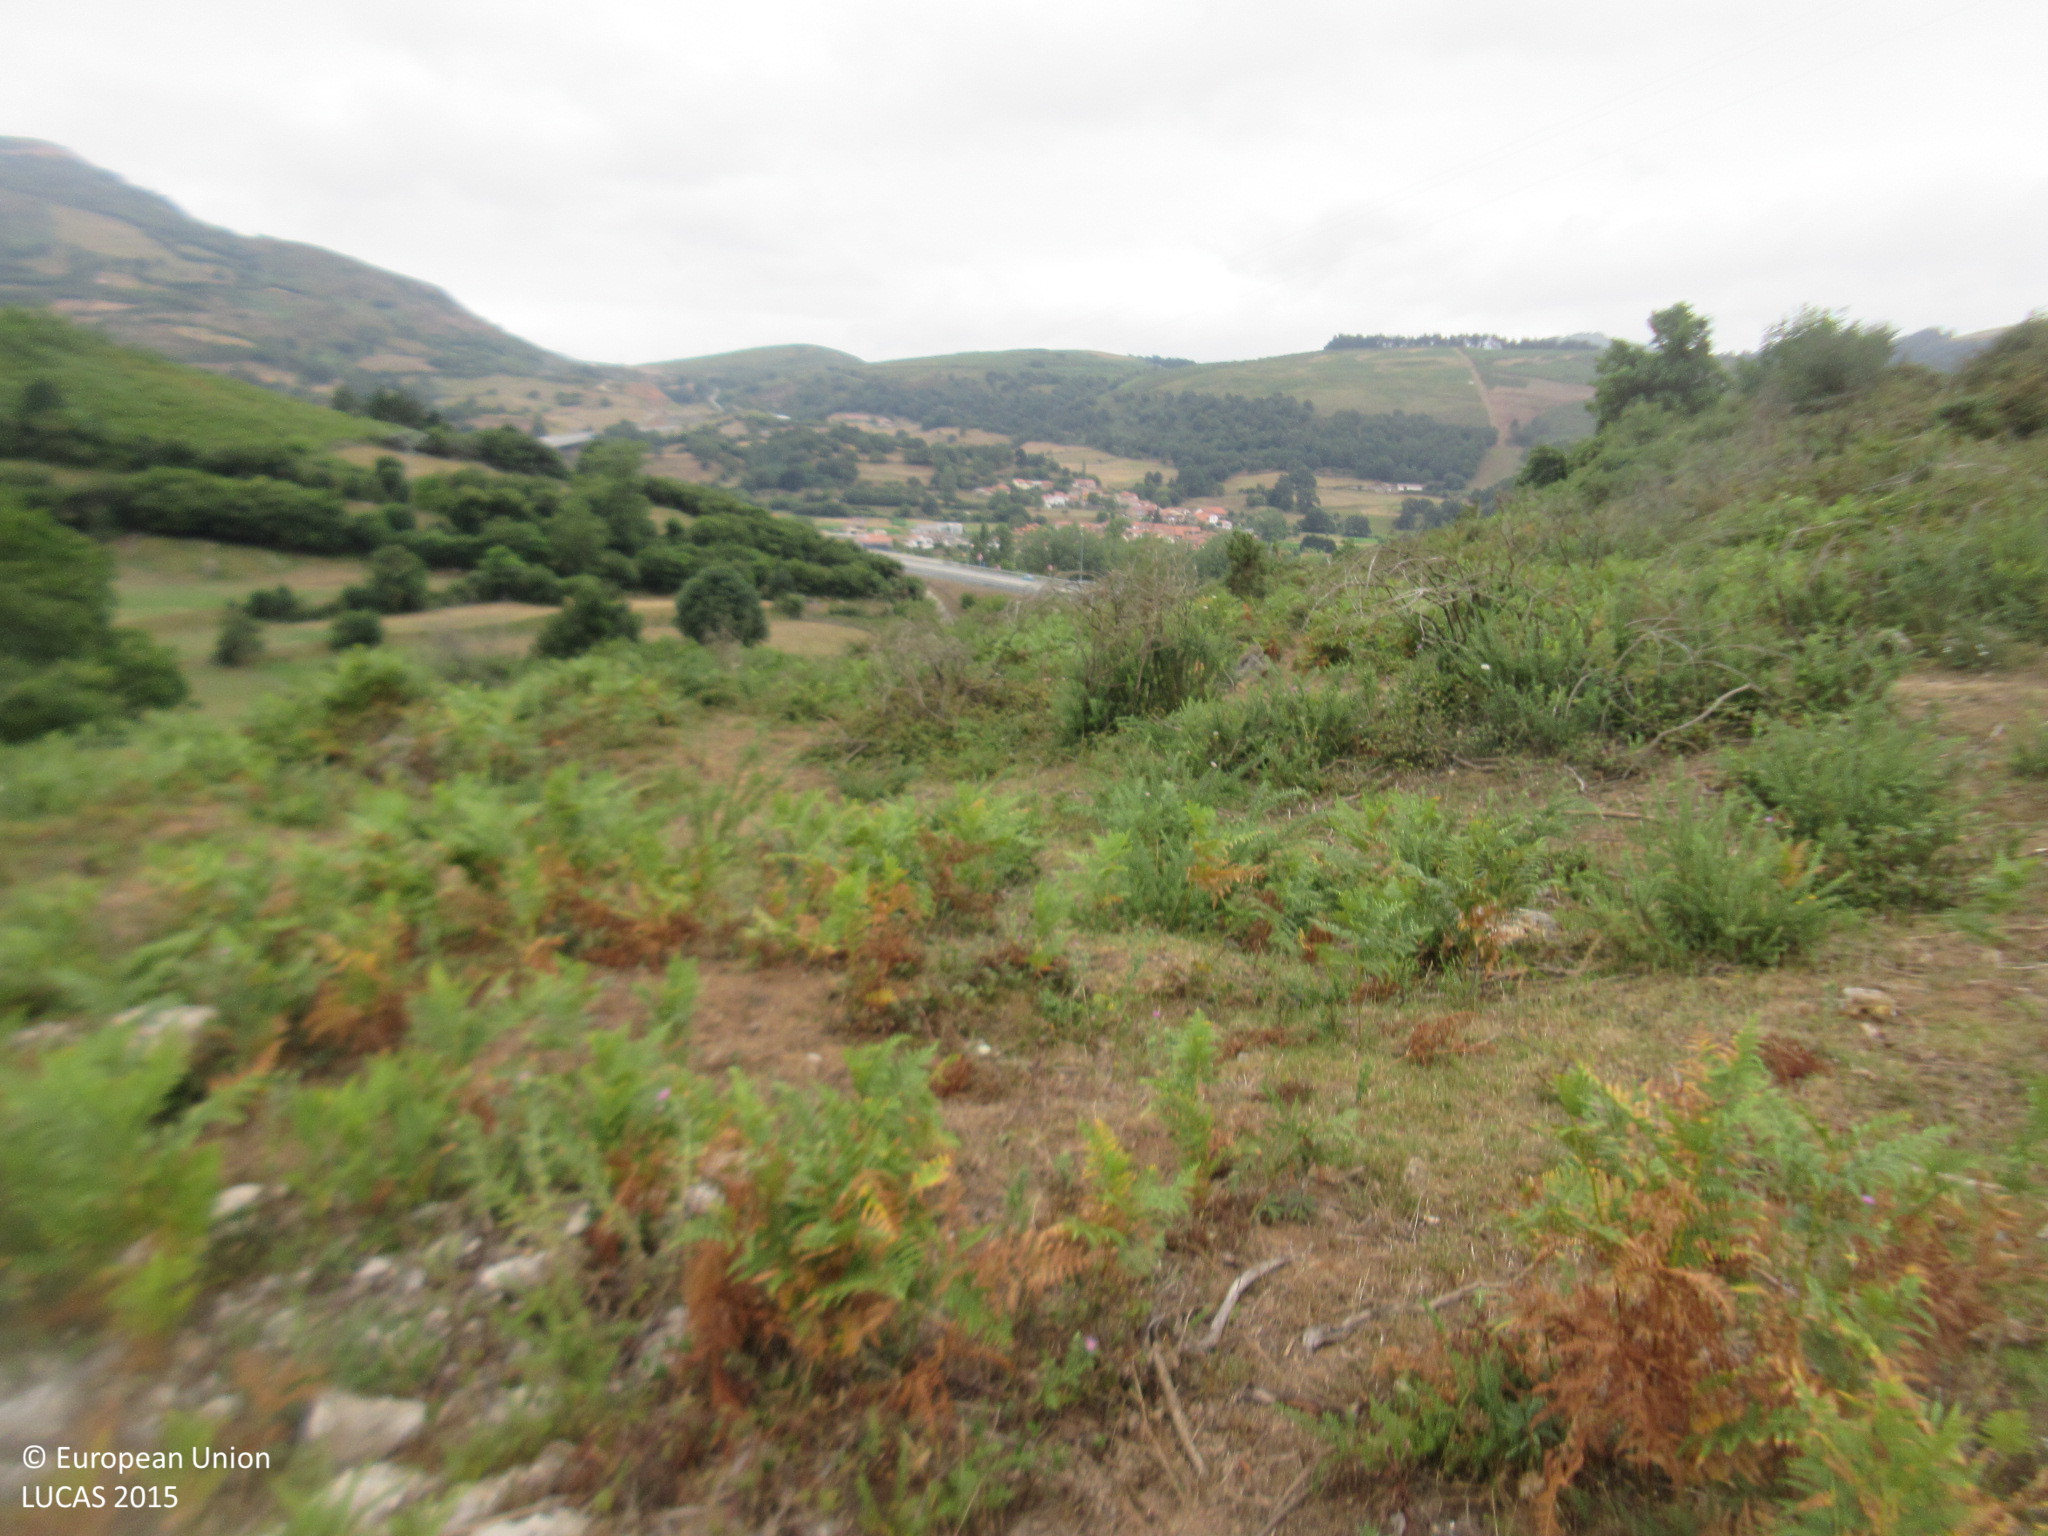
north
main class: Shrubland
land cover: Shrubland without tree cover
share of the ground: > 75 %
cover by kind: shrubs 100 %
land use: Agriculture (excluding fallow land and kitchen gardens)
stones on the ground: > 50 %
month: July
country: ES
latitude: 43.1859
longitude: -4.0649
